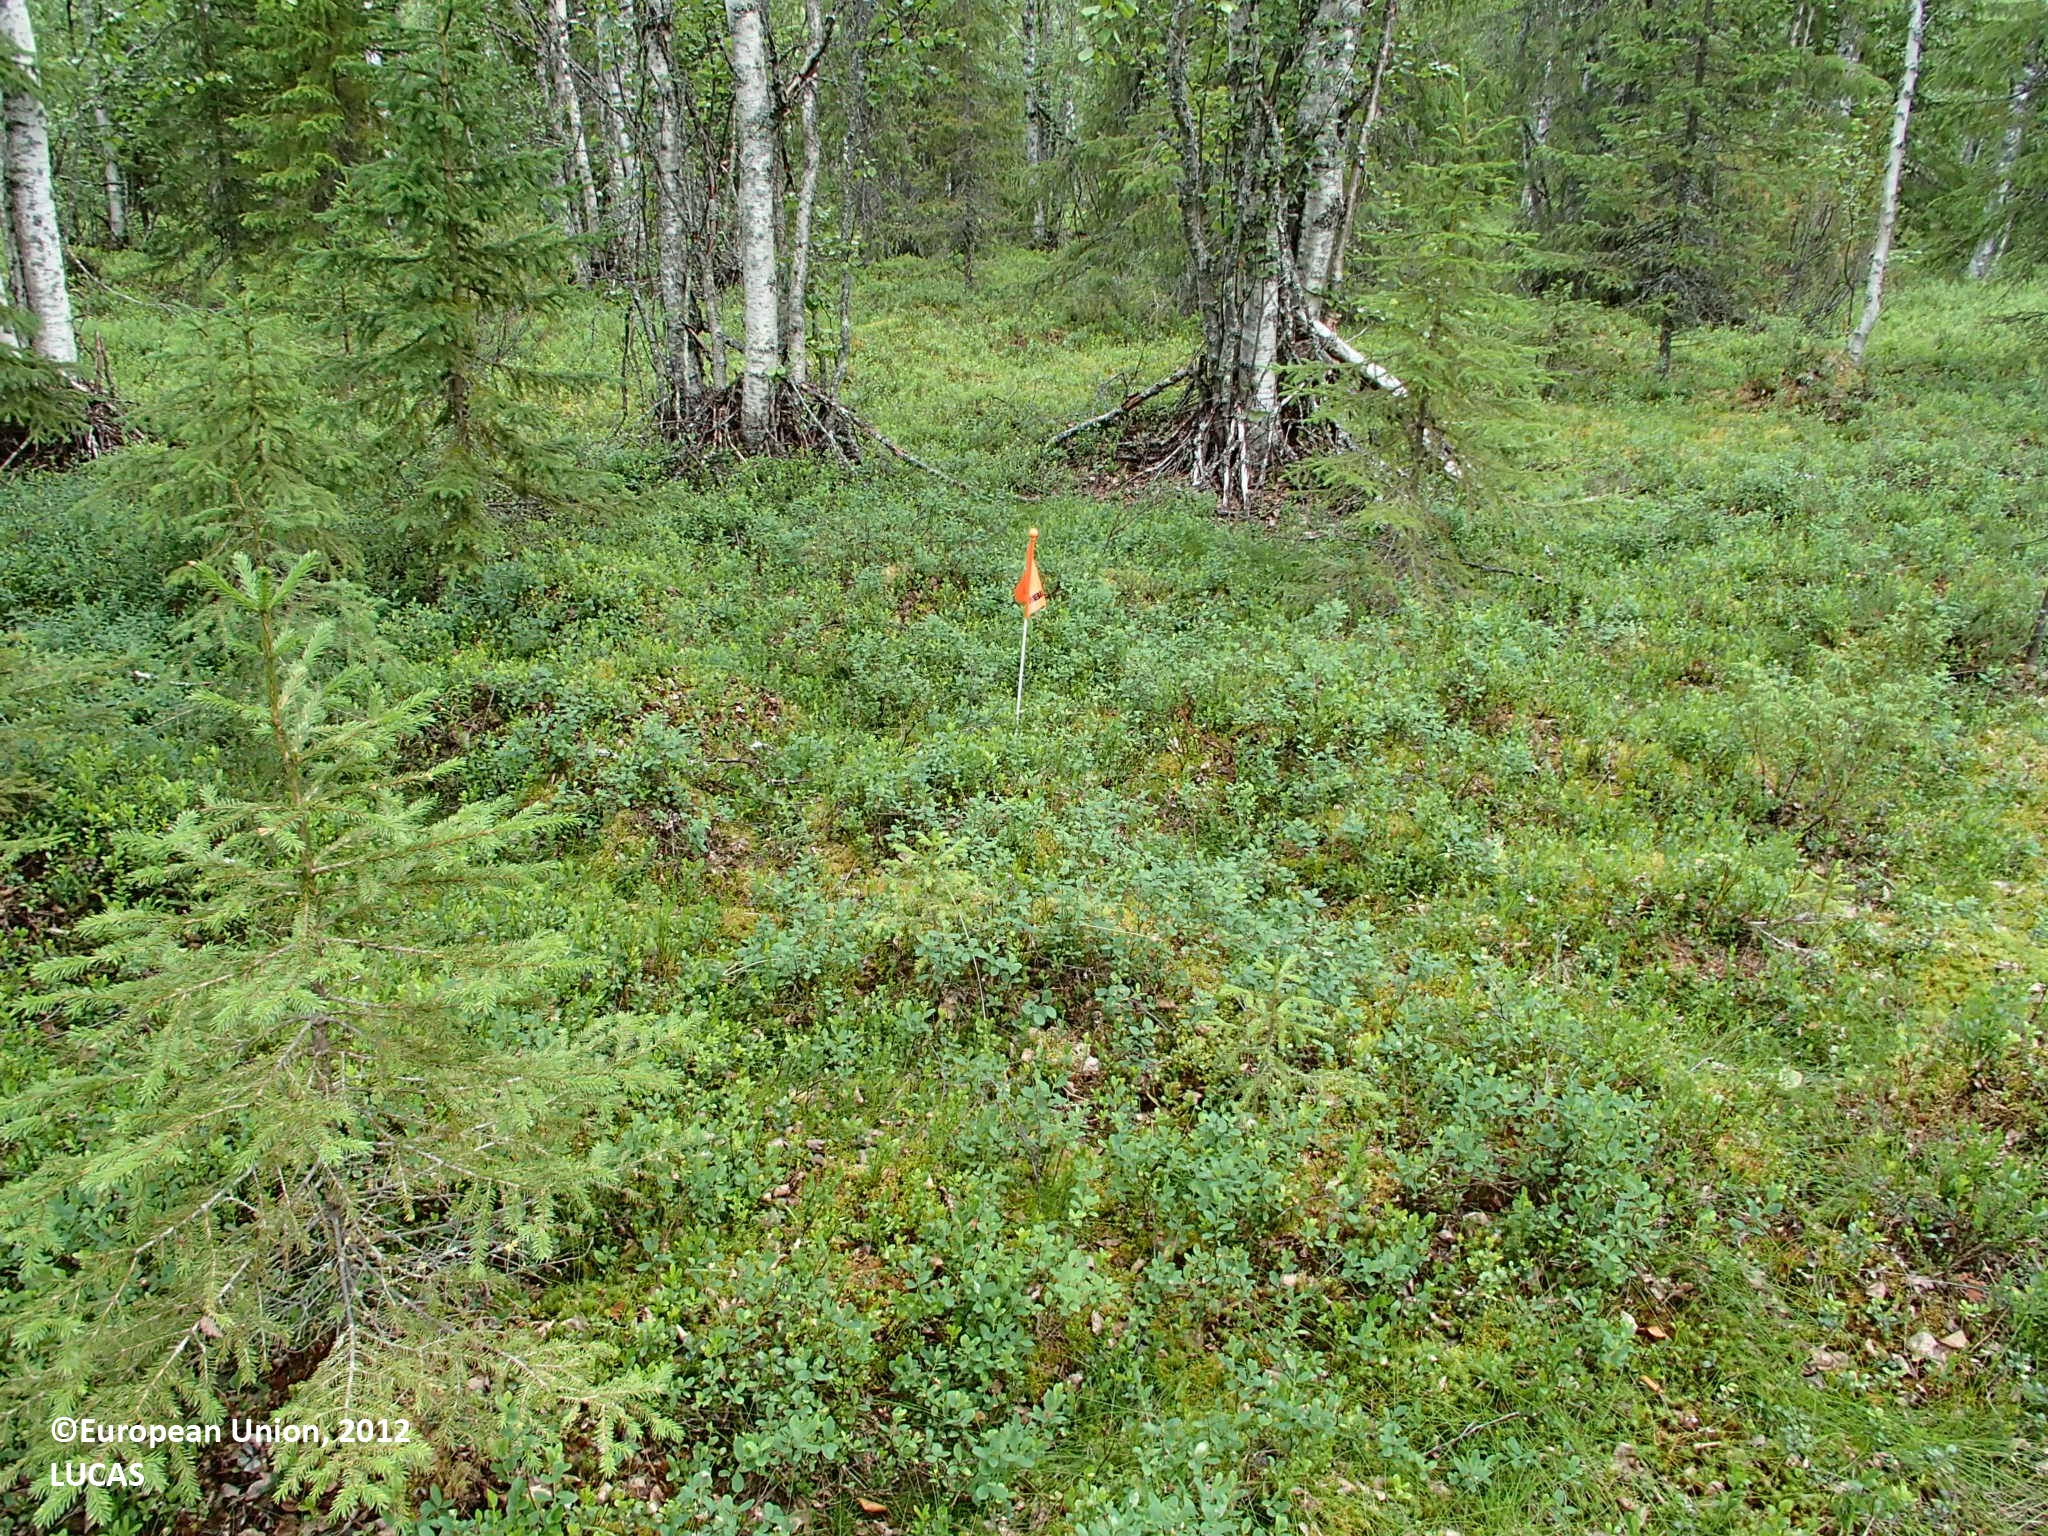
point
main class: Woodland
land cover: Other mixed woodland
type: boreal forest
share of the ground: > 75 %
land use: Forestry
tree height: > 5 m
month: July
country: FI
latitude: 67.0144
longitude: 25.5474
